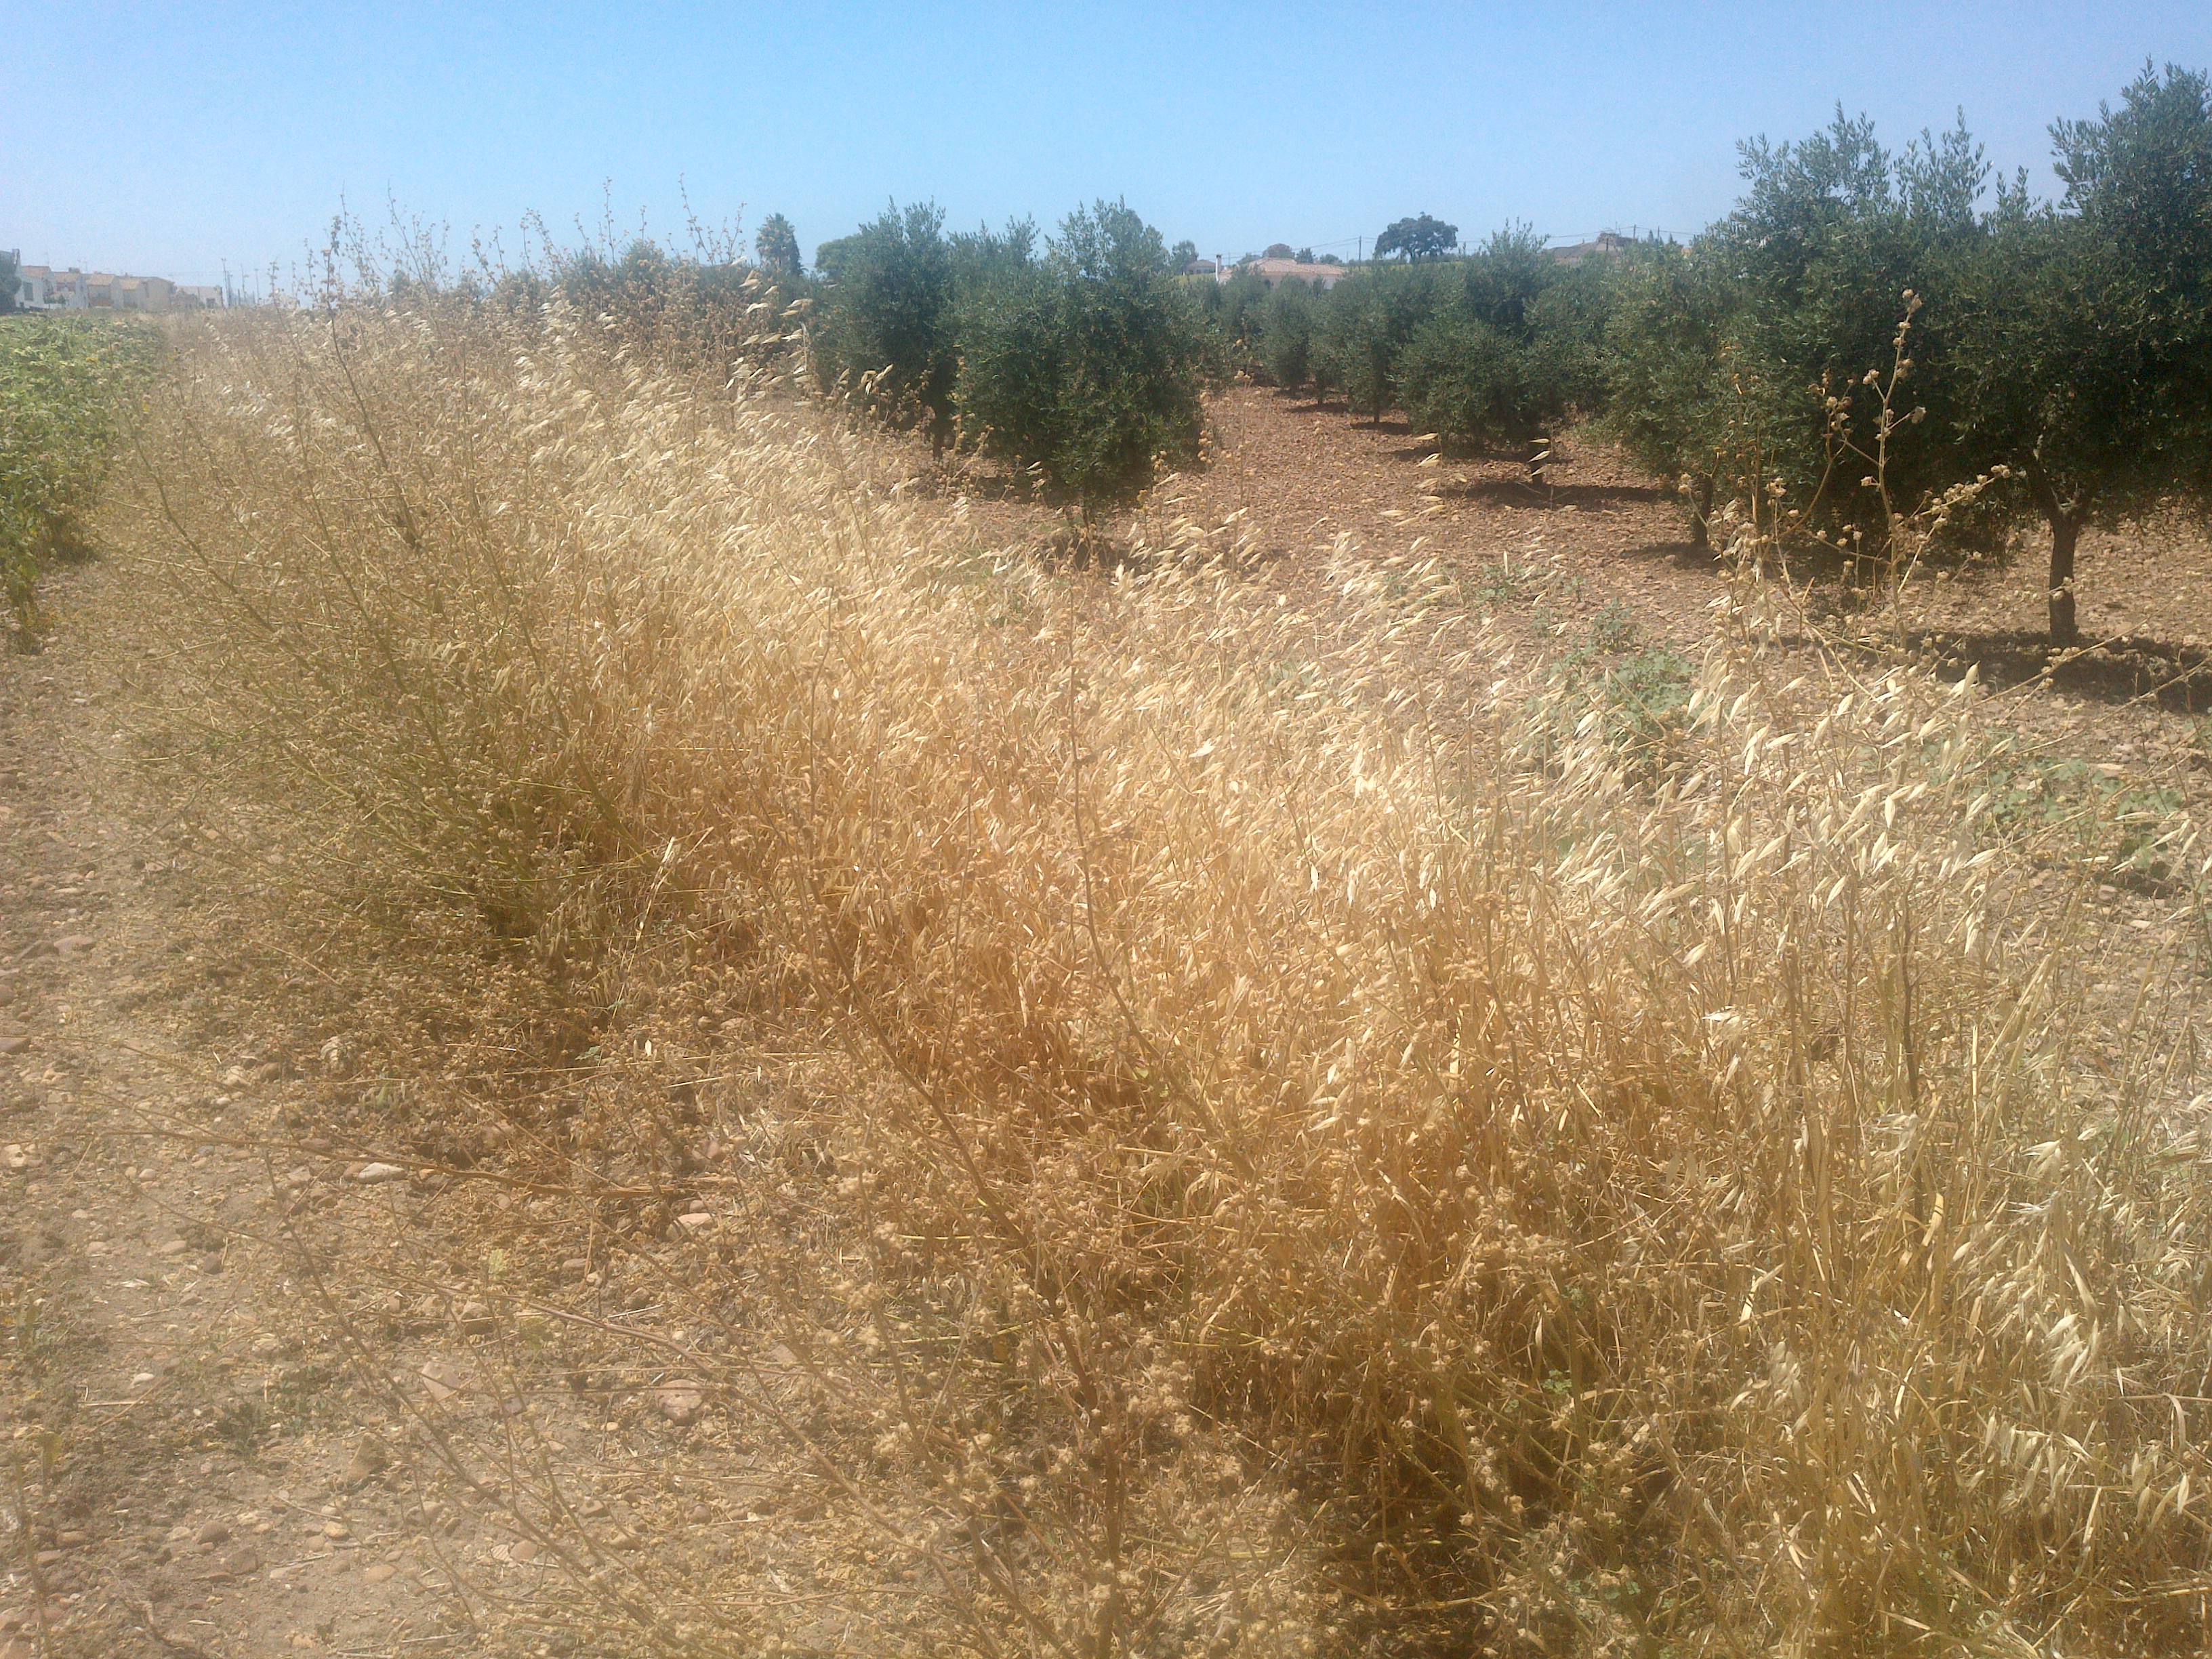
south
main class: Cropland
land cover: Sunflower
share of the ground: > 75 %
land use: Agriculture (excluding fallow land and kitchen gardens)
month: June
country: ES
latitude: 37.6387
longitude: -4.8684
